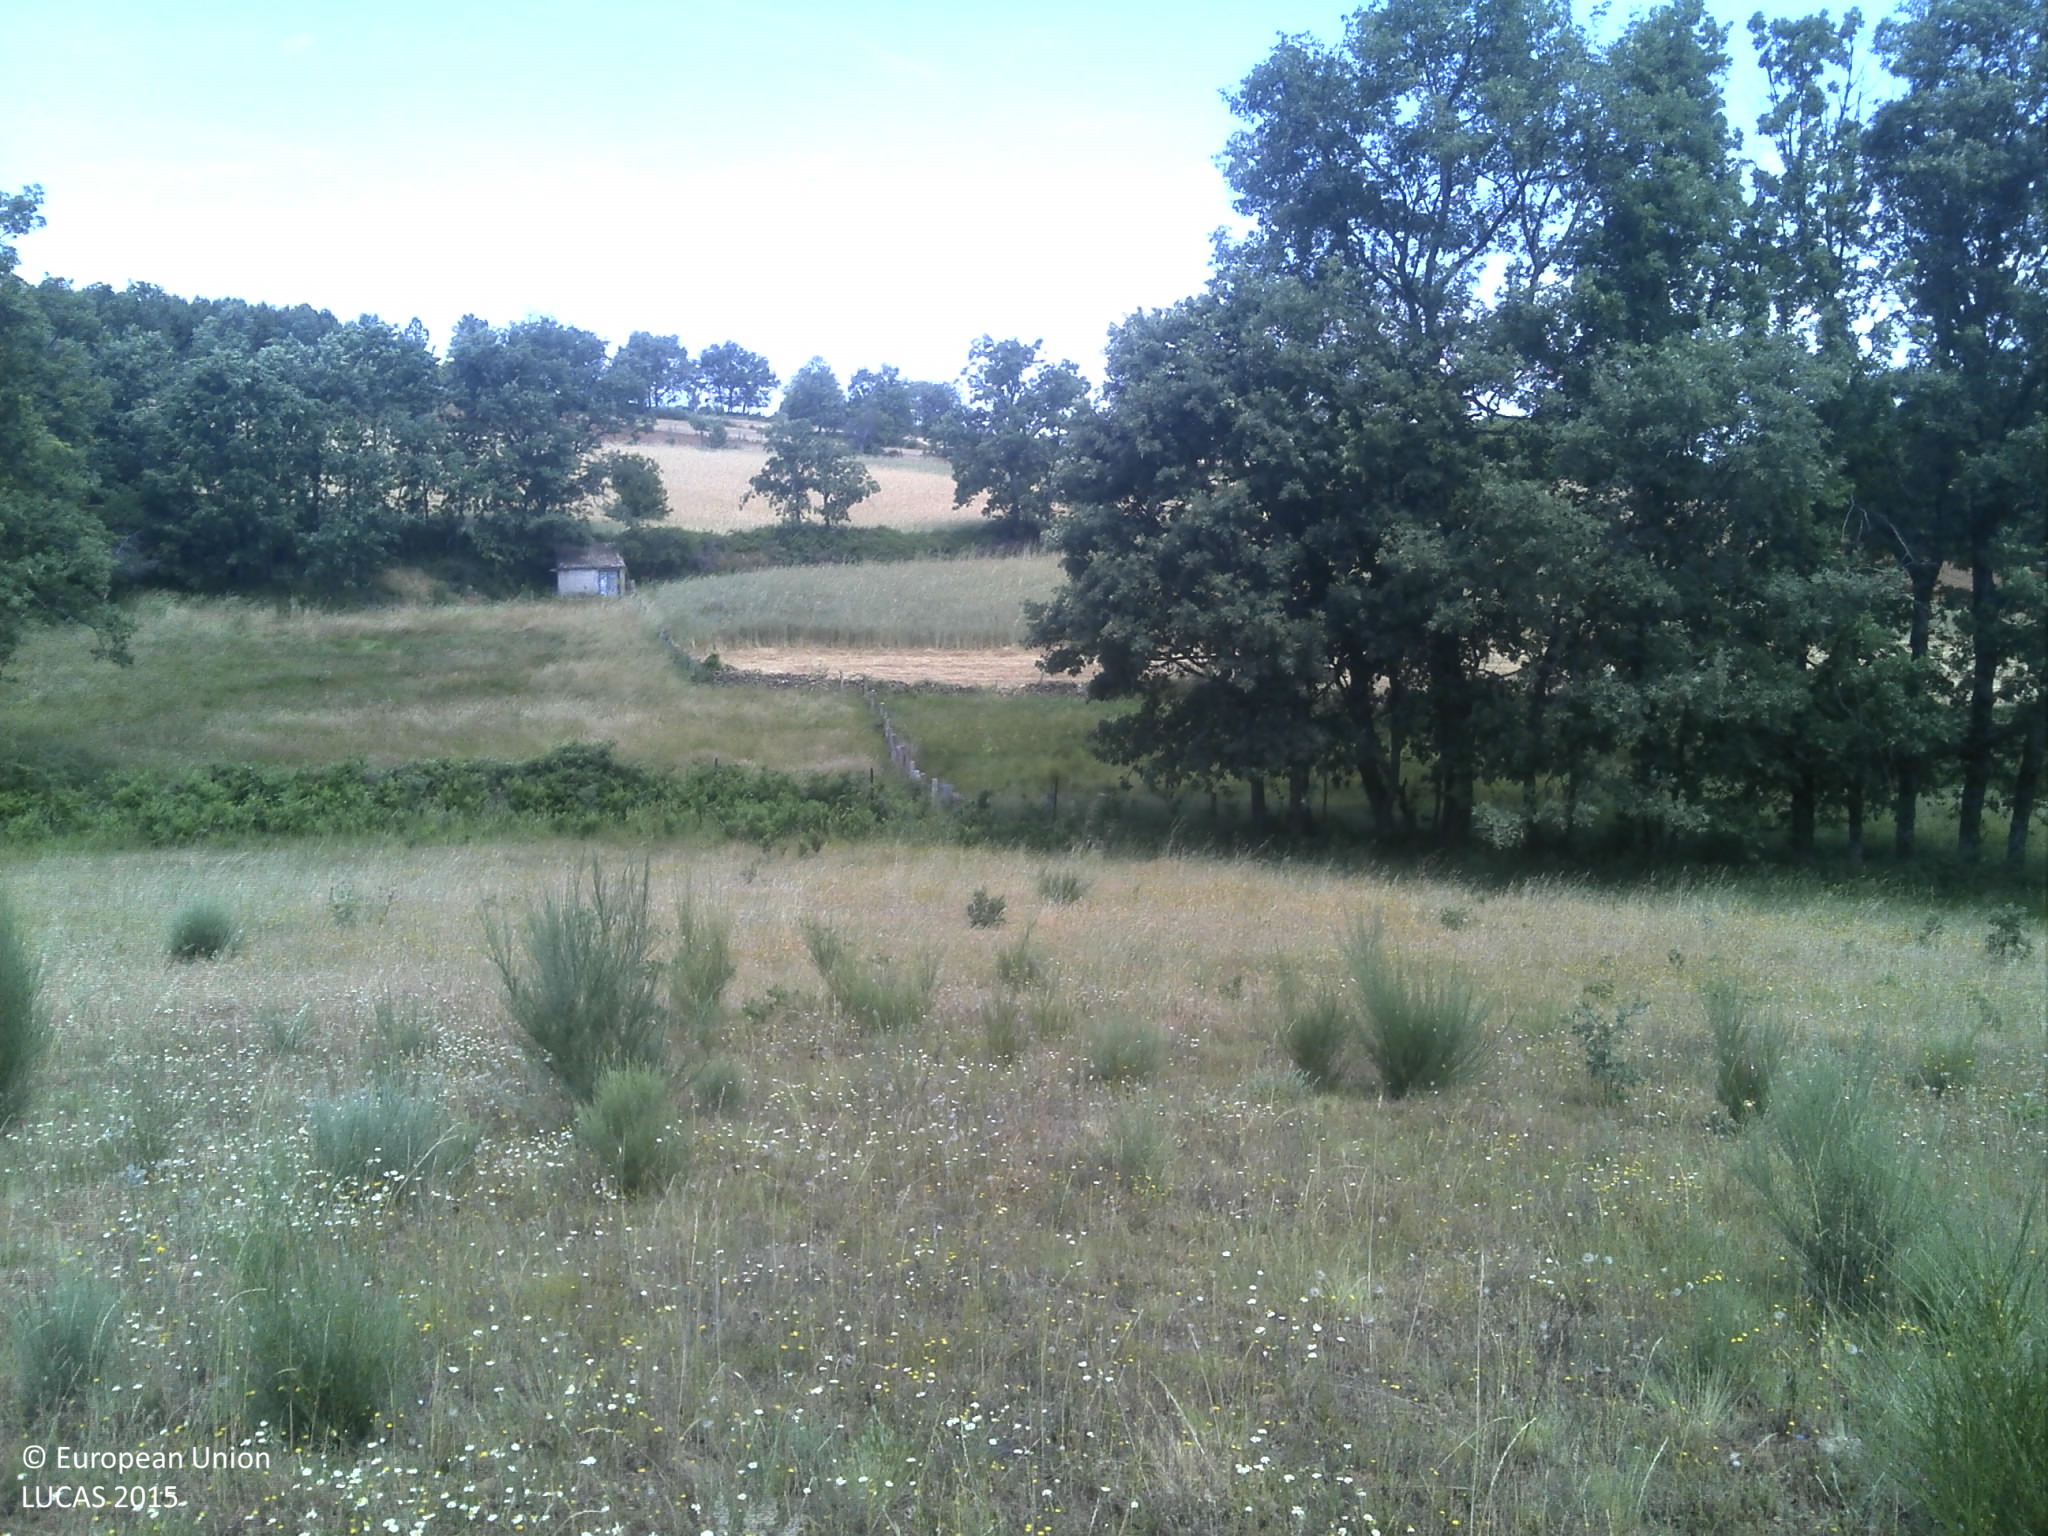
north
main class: Grassland
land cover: Grassland without tree/shrub cover
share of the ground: 25 - 50 %
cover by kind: herbaceous plants 50 %, unconsolidated bare surface 40 %, shrubs 5 %
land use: Agriculture (excluding fallow land and kitchen gardens)
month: June
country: PT
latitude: 40.3446
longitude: -6.9657
